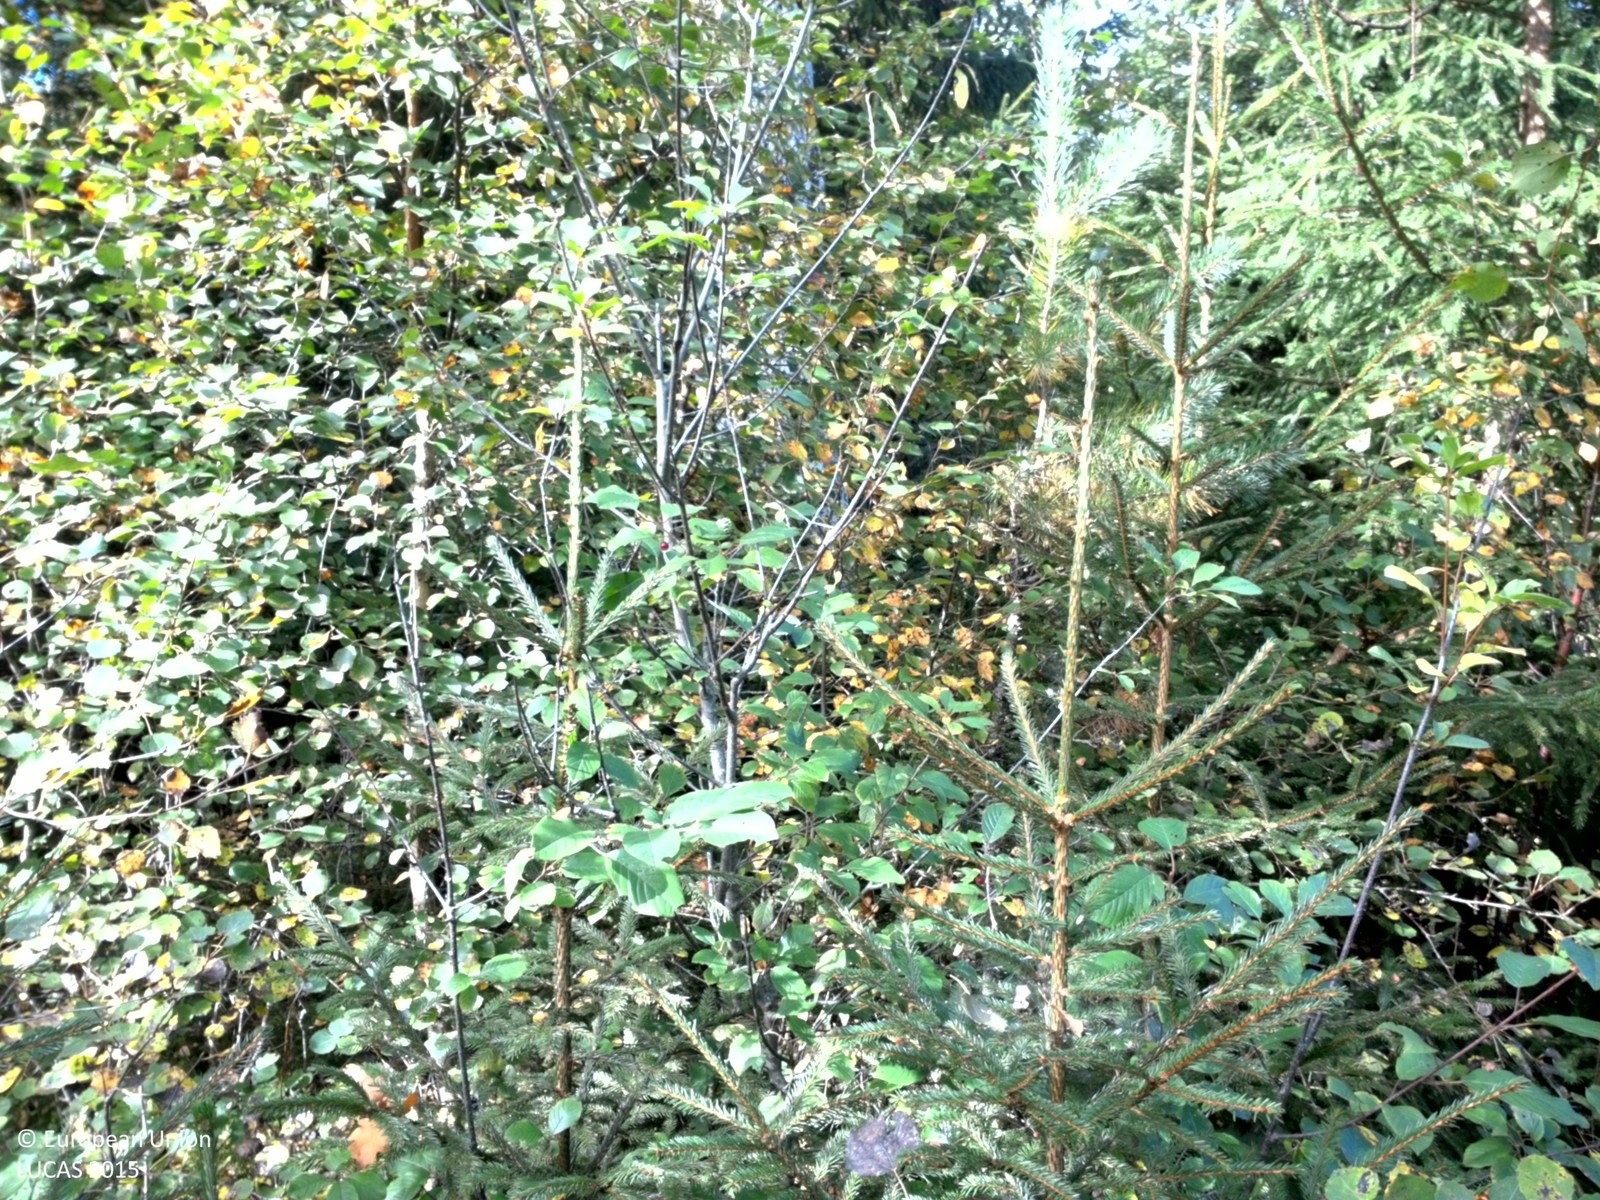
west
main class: Woodland
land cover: Broadleaved woodland
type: hemiboreal forest and nemoral coniferous forest and mixed broadleaved-coniferous forest
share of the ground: > 75 %
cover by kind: broadleaved forest trees 80 %, herbaceous plants 15 %, coniferous forest trees 5 %
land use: Forestry
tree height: > 5 m
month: September
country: SE
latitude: 58.0391
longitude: 13.1284
